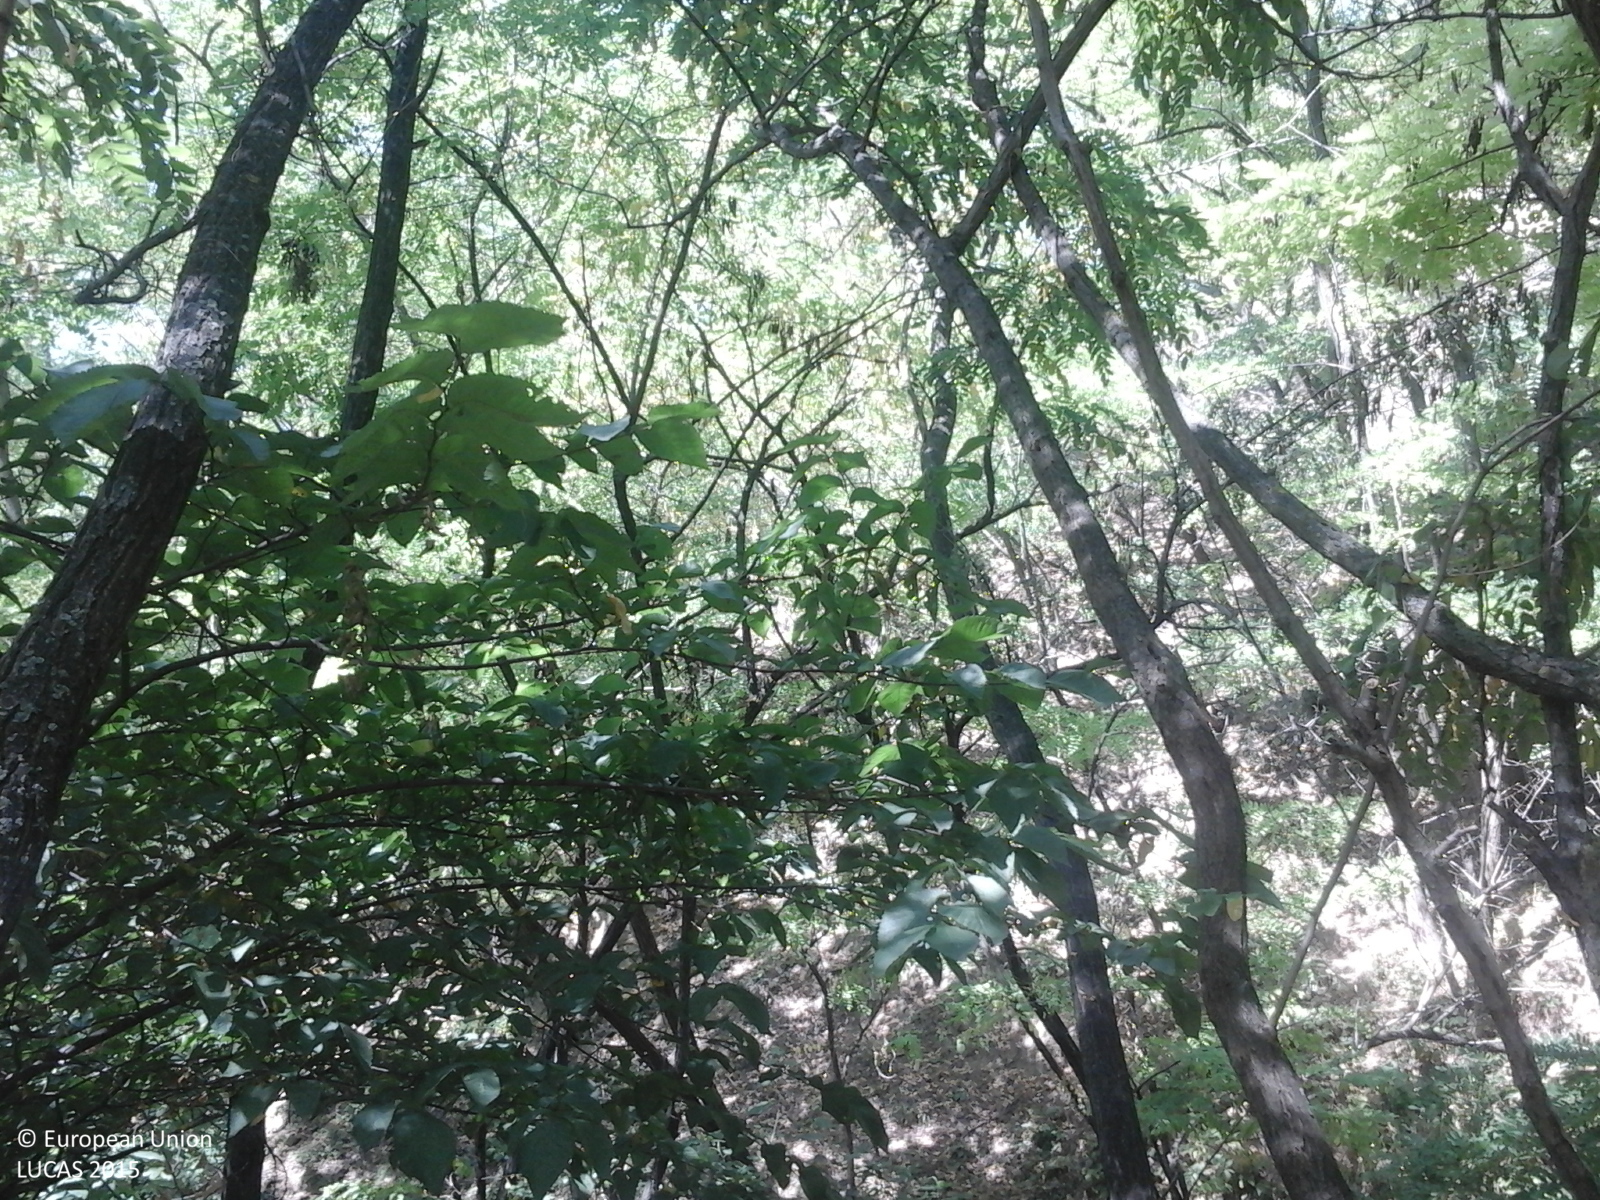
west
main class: Woodland
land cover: Broadleaved woodland
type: exotic forest
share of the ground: > 75 %
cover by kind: broadleaved forest trees 100 %
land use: Forestry
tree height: > 5 m
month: July
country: RO
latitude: 46.1970
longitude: 27.1914
